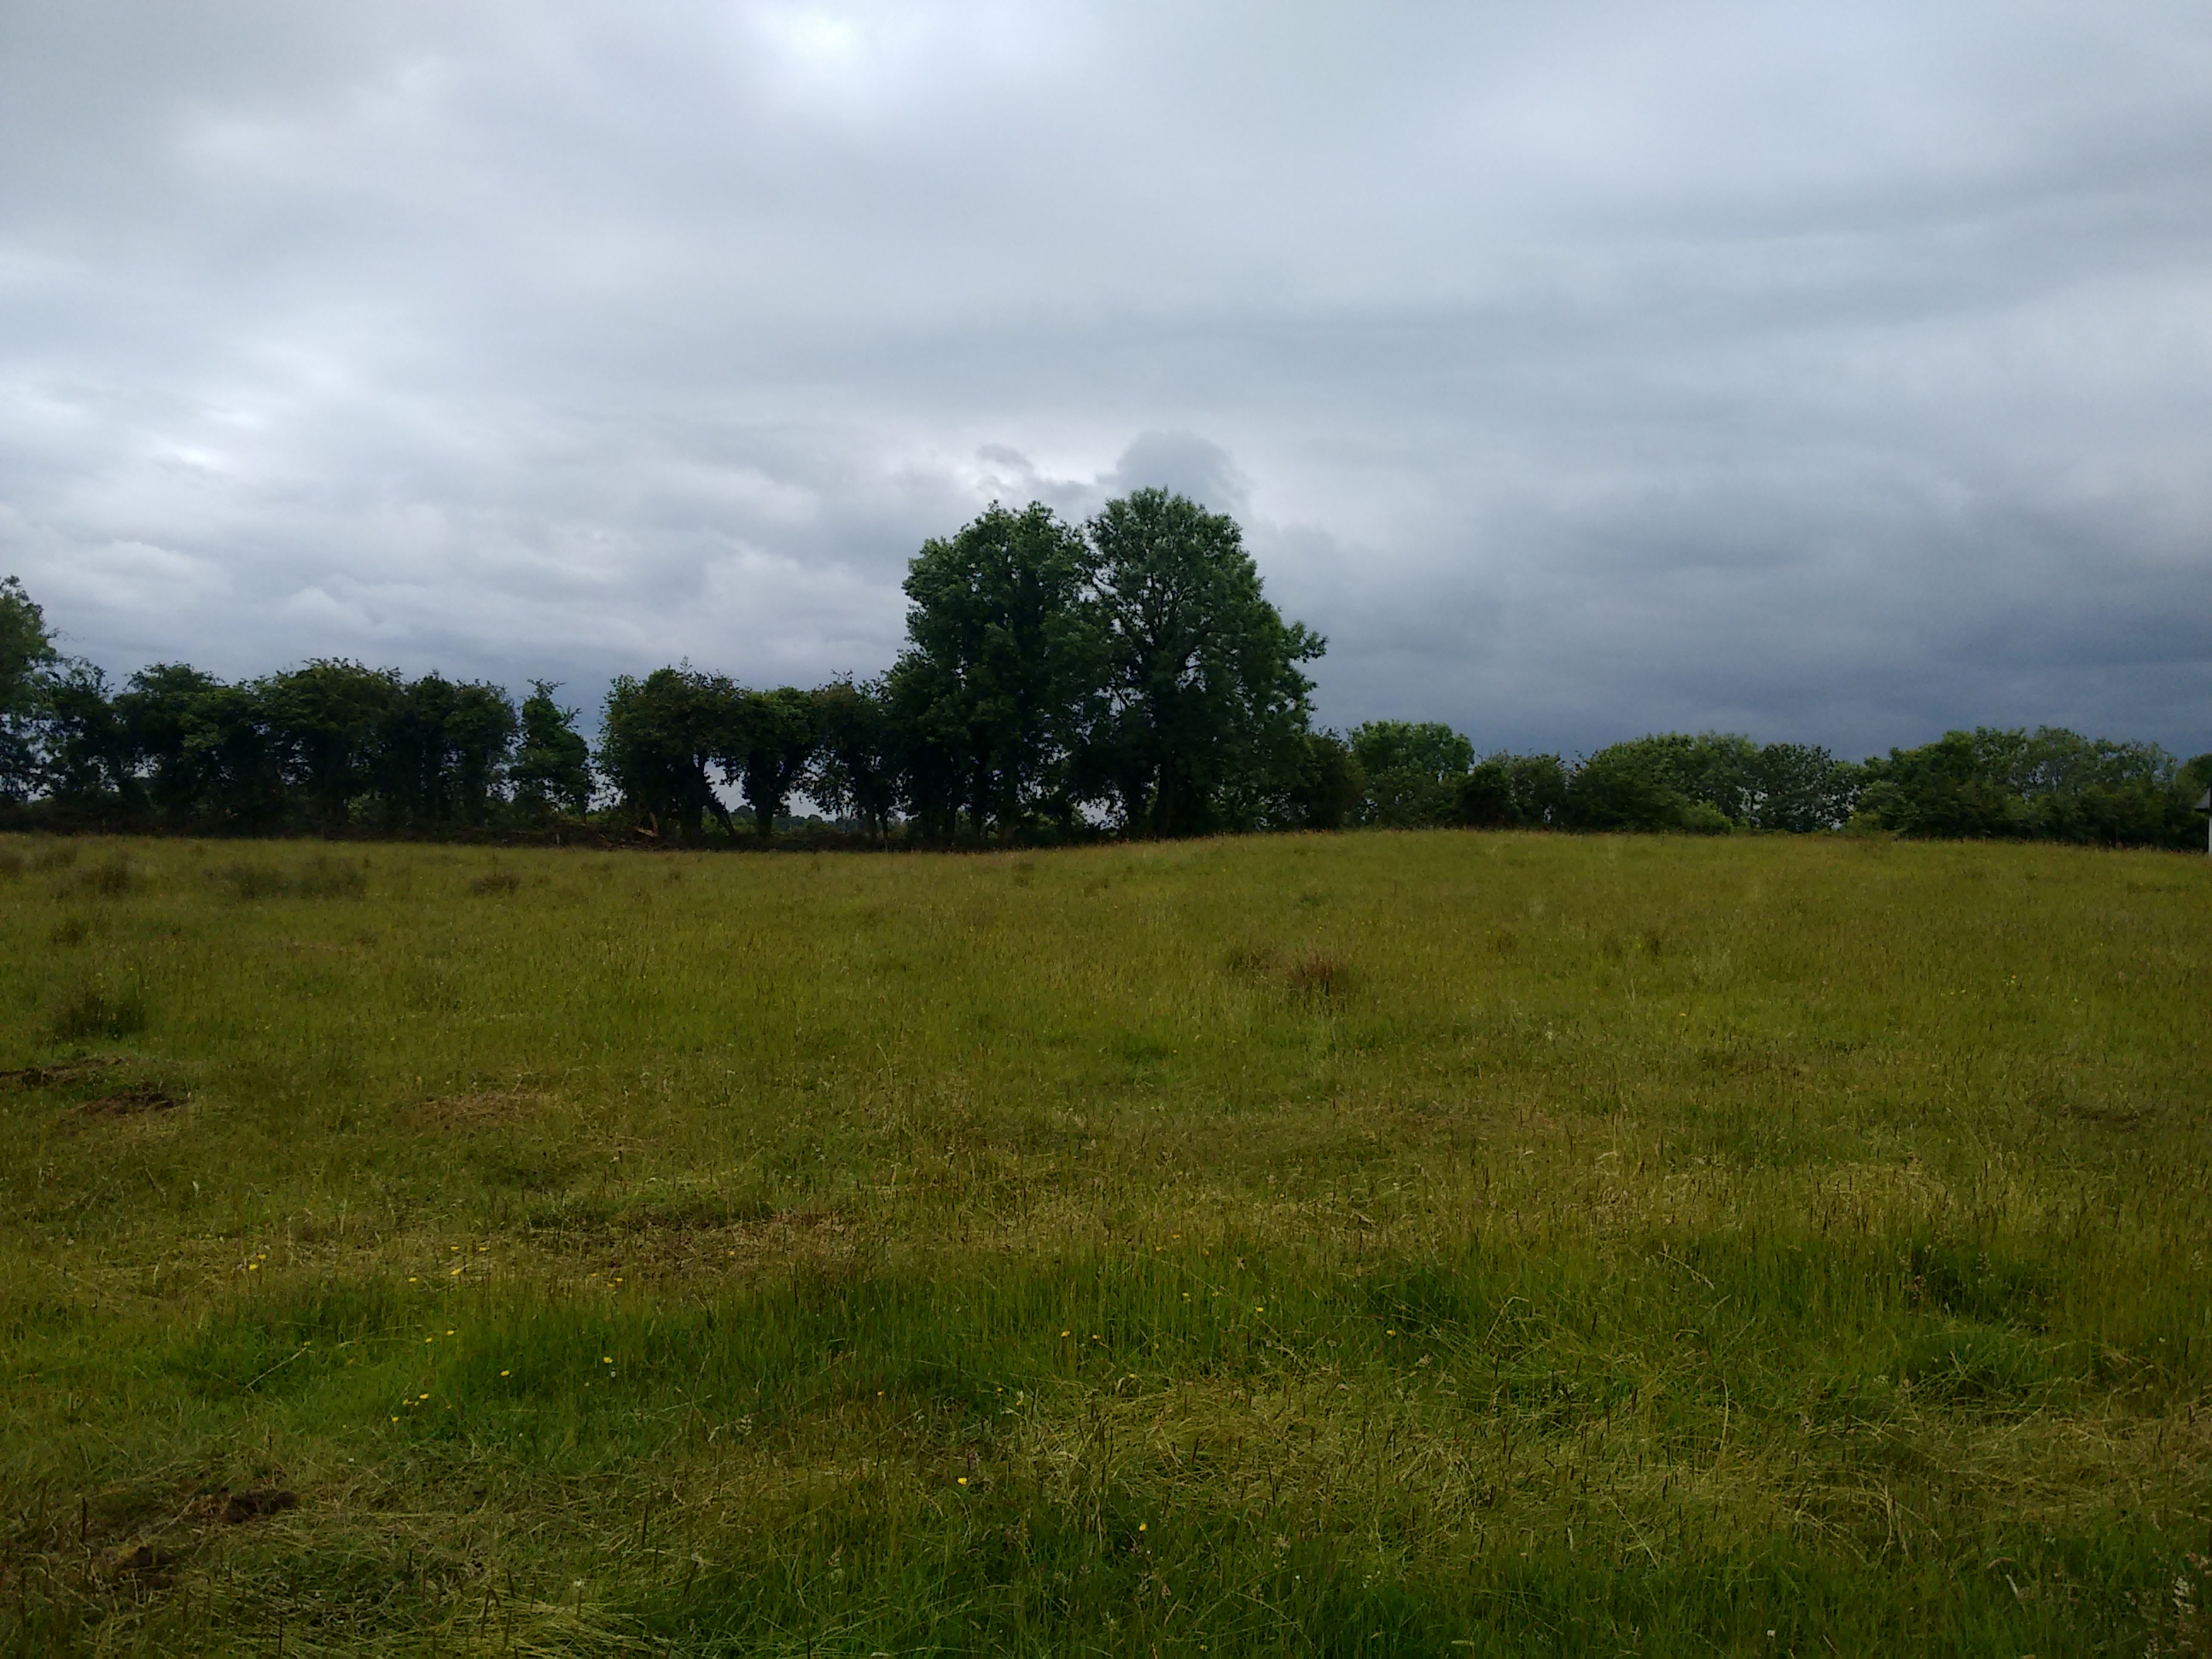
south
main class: Grassland
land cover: Grassland without tree/shrub cover
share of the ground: > 75 %
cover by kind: herbaceous plants 95 %, shrubs 5 %
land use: Agriculture (excluding fallow land and kitchen gardens)
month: June
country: IE
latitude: 53.3983
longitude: -7.7788
